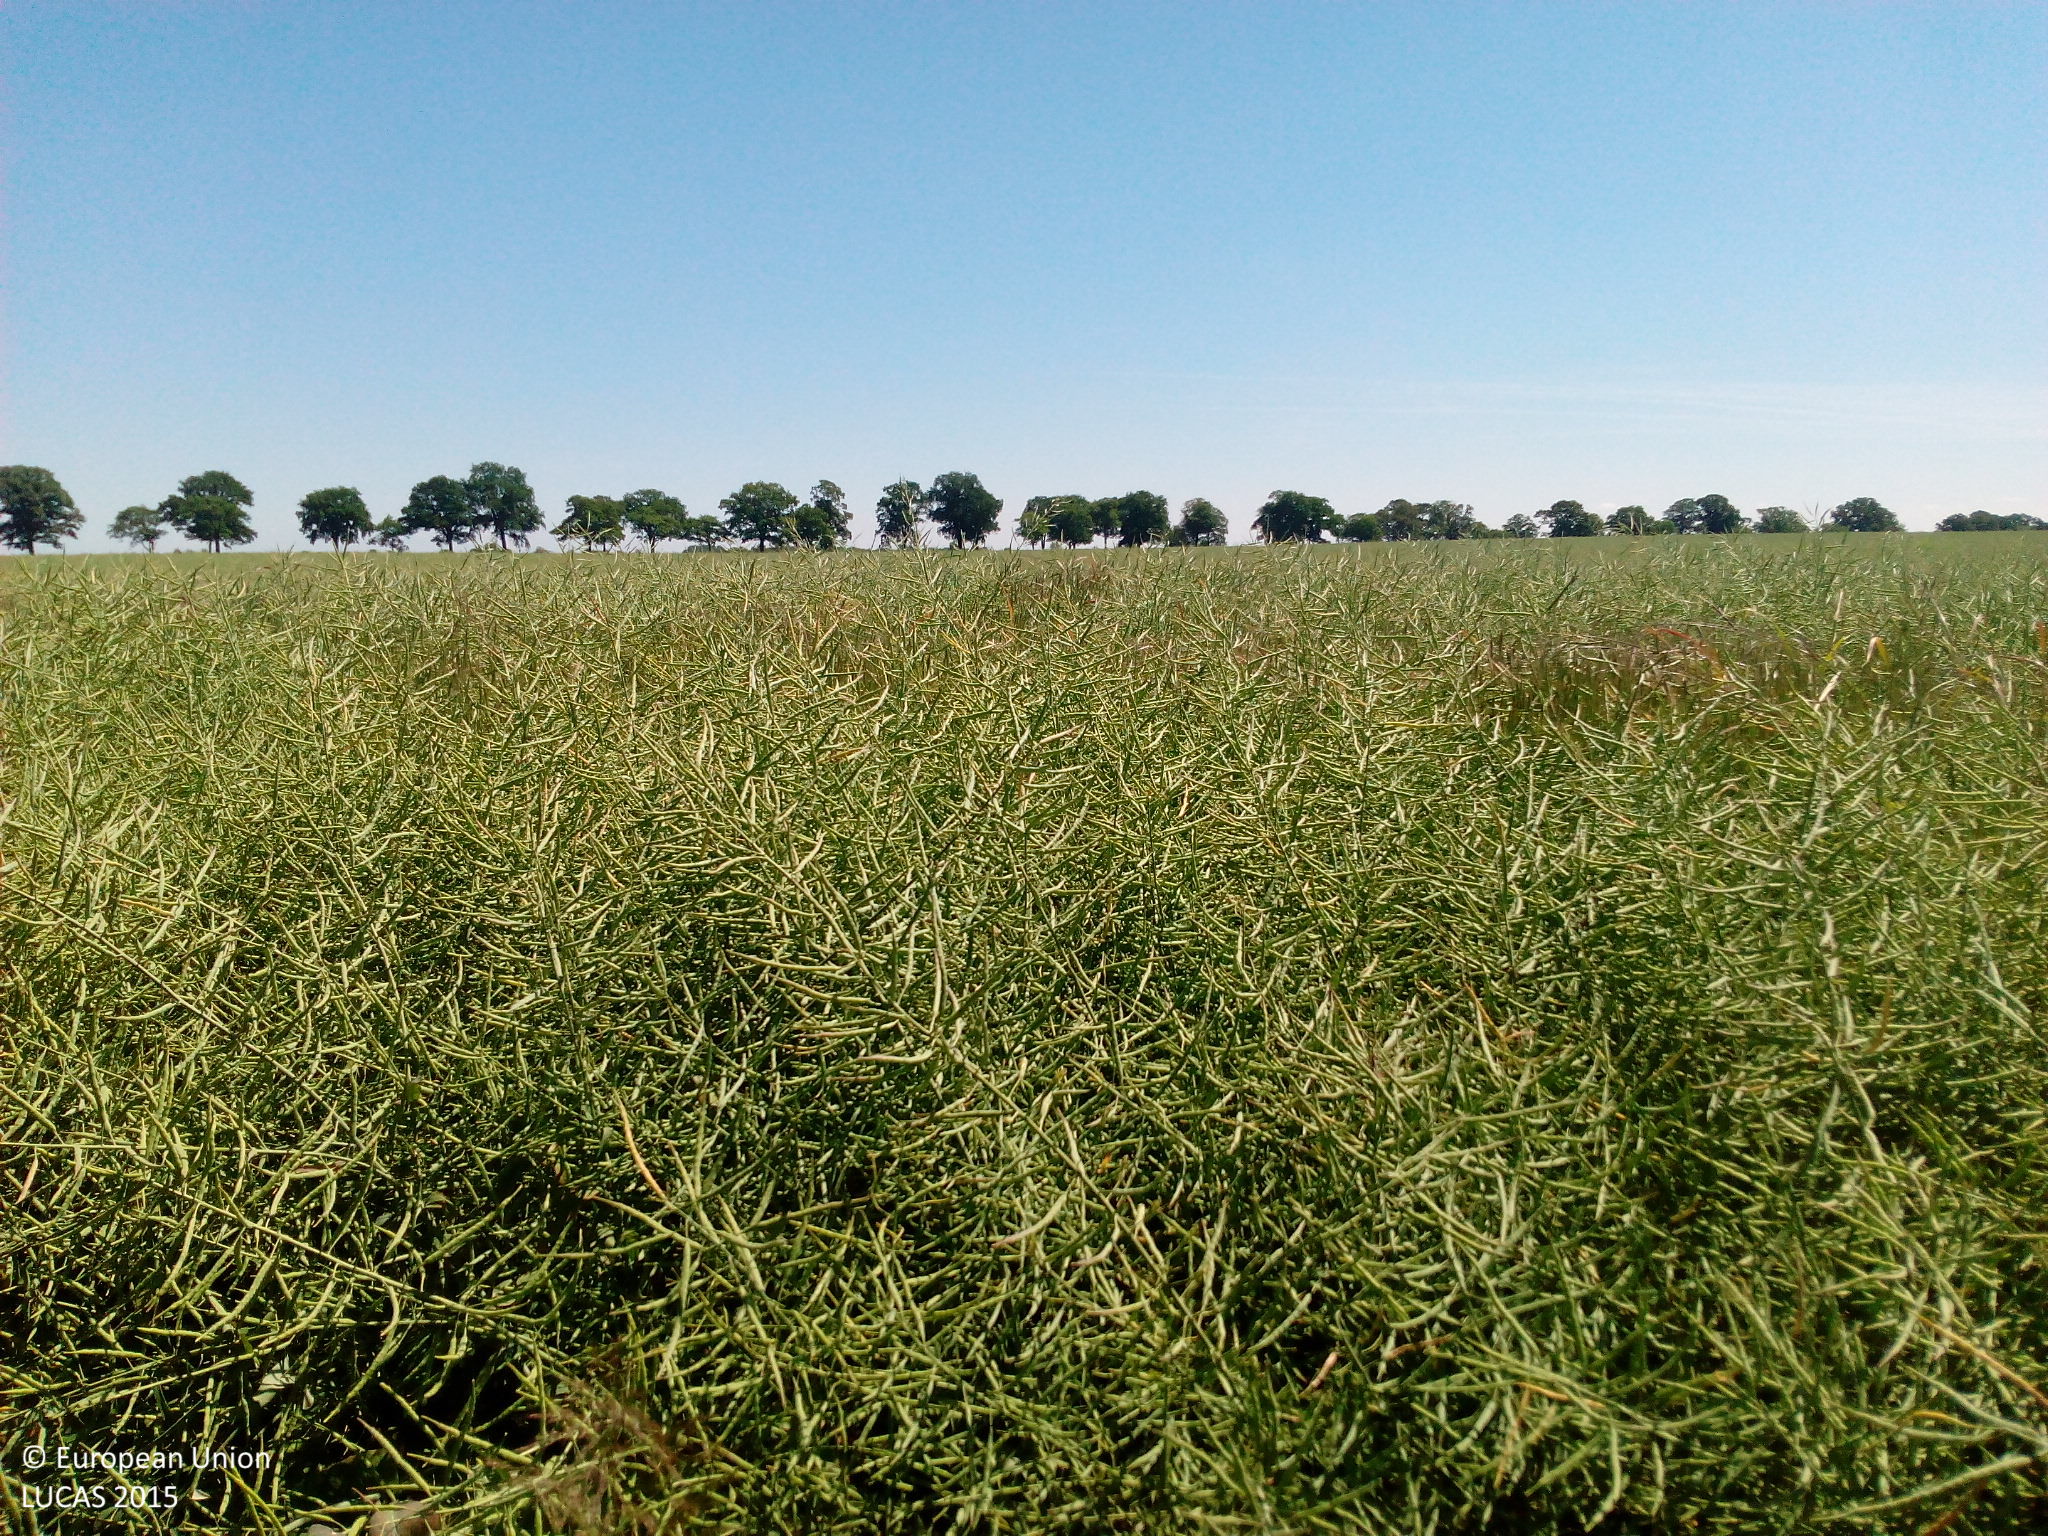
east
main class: Cropland
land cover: Rape and turnip rape
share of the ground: > 75 %
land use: Agriculture (excluding fallow land and kitchen gardens)
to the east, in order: Rape and turnip rape
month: June
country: DE
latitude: 52.6724
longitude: 12.6172
